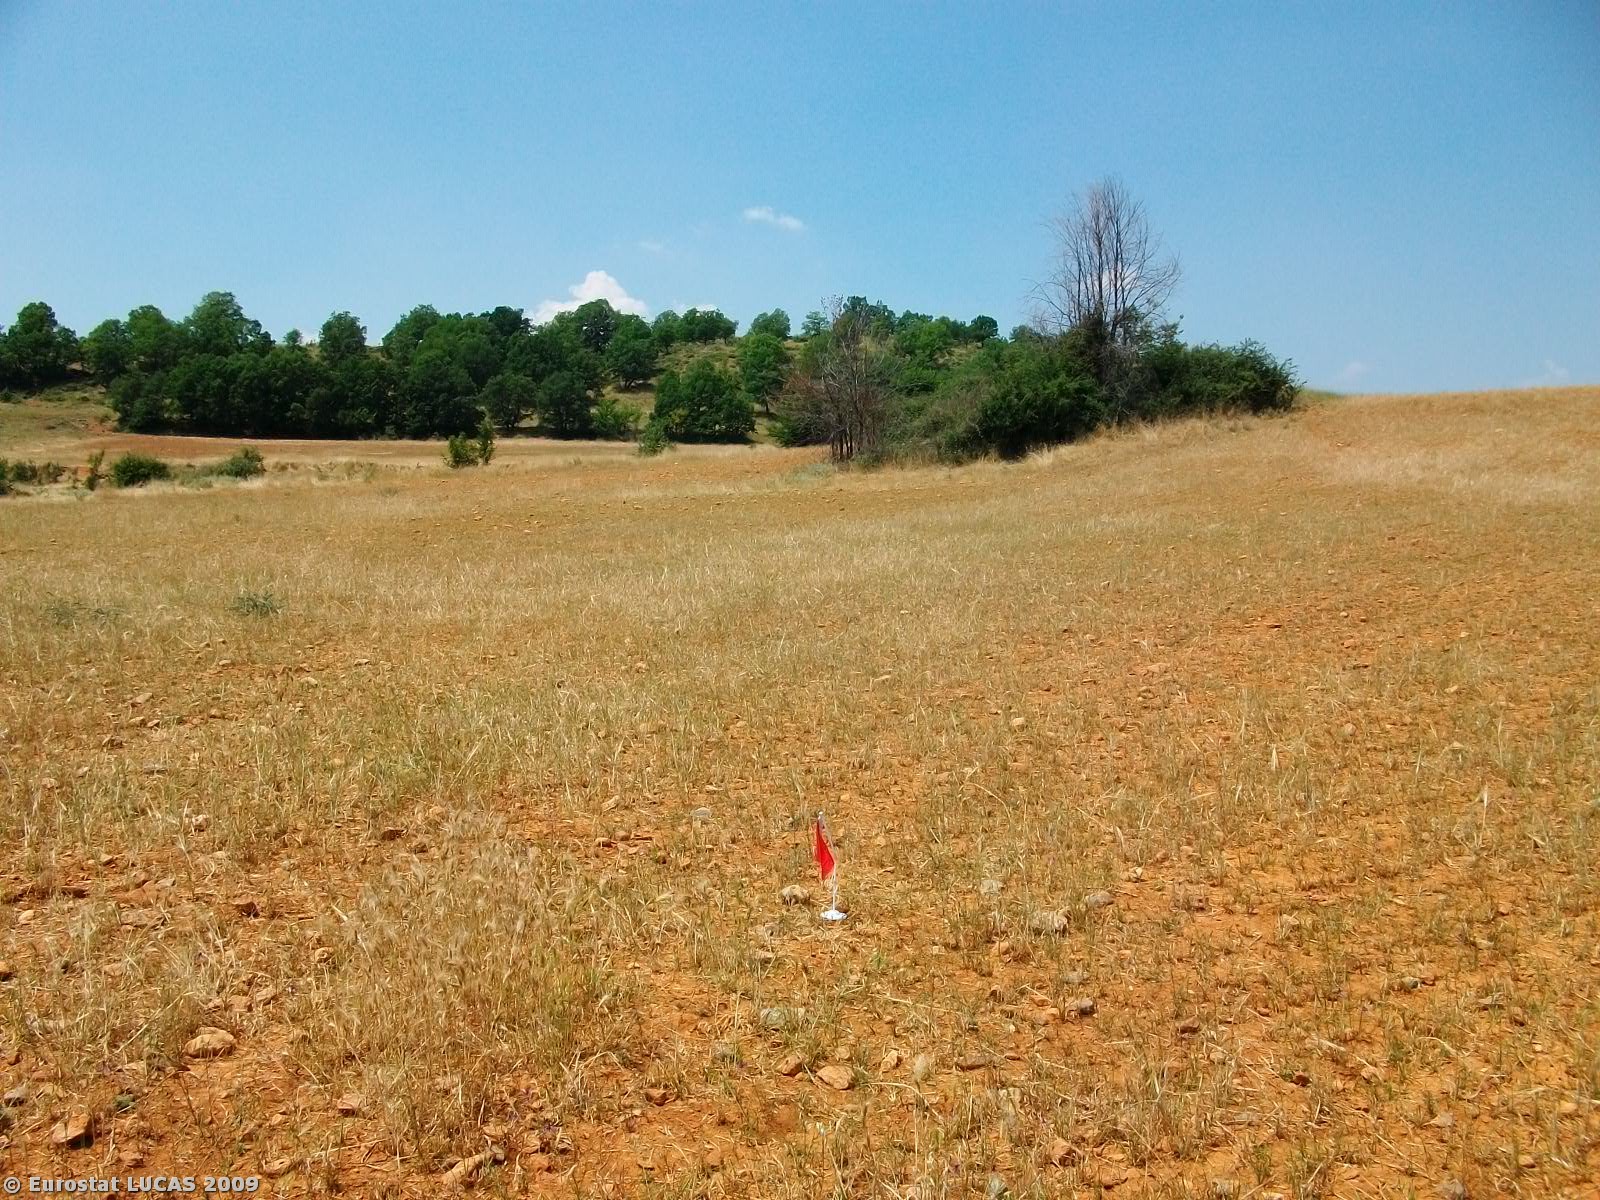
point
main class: Grassland
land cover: Grassland without tree/shrub cover
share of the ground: 50 - 75 %
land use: Agriculture (excluding fallow land and kitchen gardens)
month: July
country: GR
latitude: 40.6771
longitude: 21.8630
